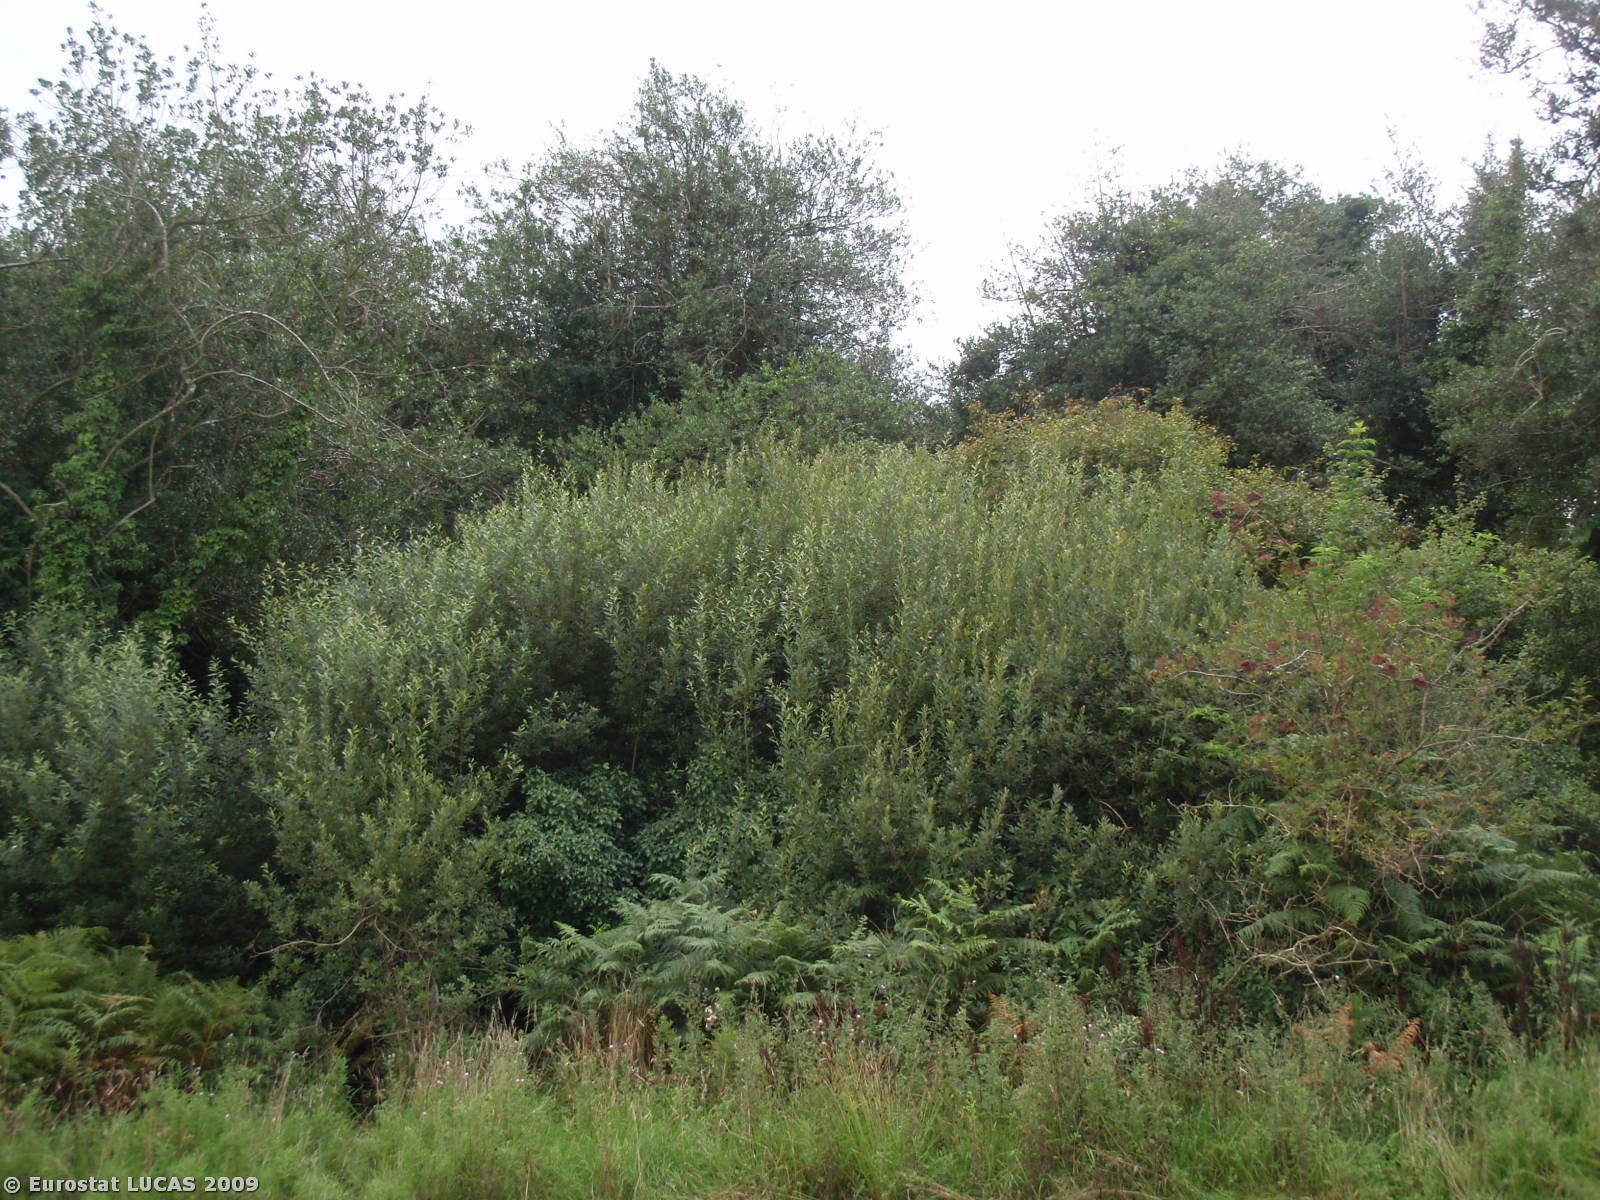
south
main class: Grassland
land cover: Grassland without tree/shrub cover
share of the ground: > 75 %
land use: Agriculture (excluding fallow land and kitchen gardens)
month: August
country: GB
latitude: 50.7590
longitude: -2.0664
